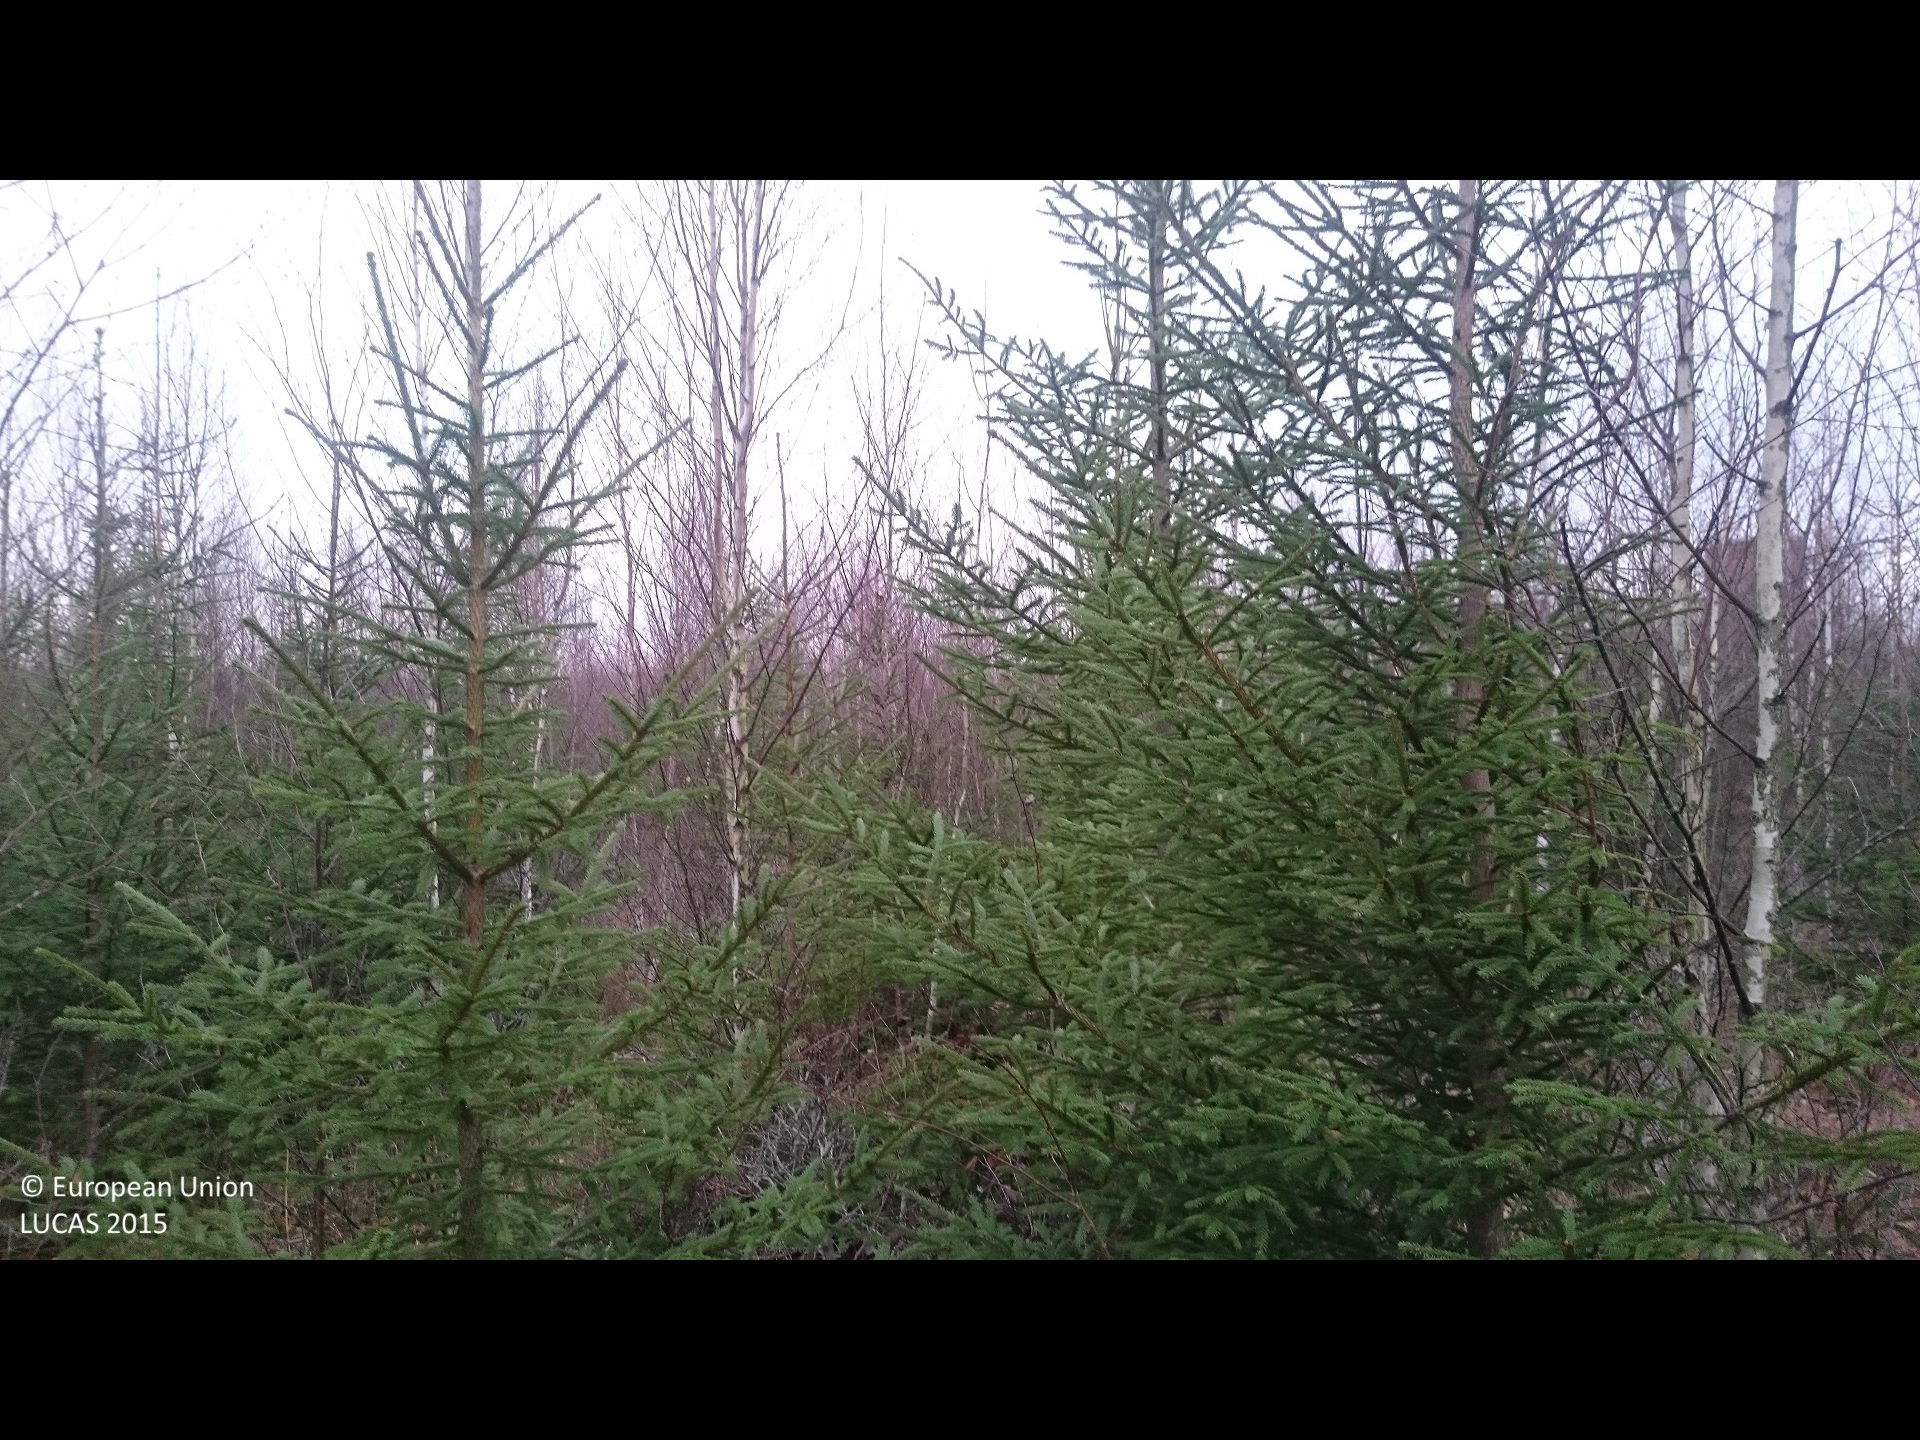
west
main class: Woodland
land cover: Spruce dominated mixed woodland
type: boreal forest
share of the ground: 50 - 75 %
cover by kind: coniferous forest trees 35 %, broadleaved forest trees 30 %, shrubs 20 %, herbaceous plants 10 %, lichens and mosses 5 %
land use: Forestry
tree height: < 5 m
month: November
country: SE
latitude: 56.7537
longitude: 15.9362
